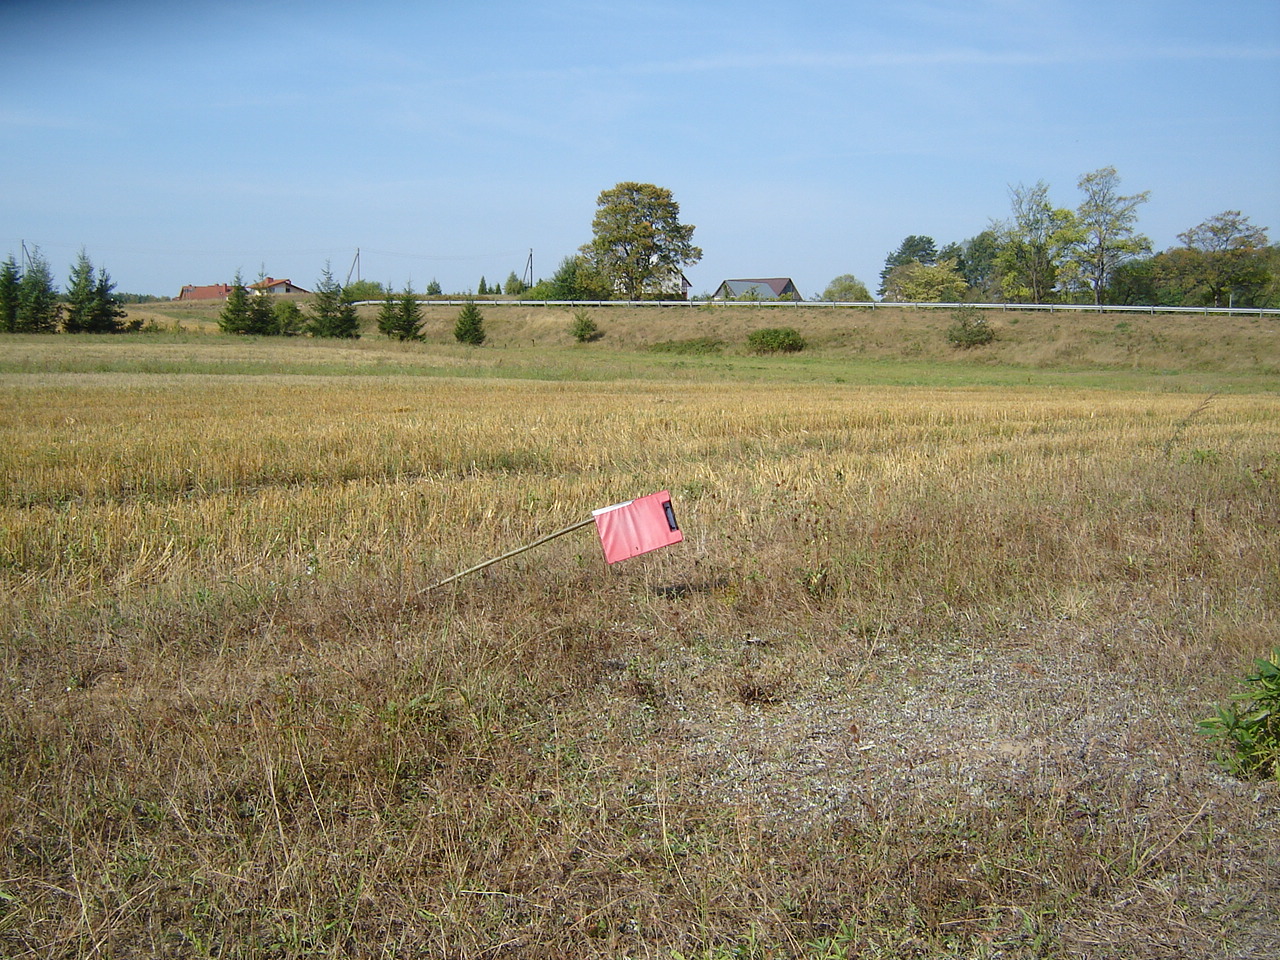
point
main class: Grassland
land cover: Grassland without tree/shrub cover
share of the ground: > 75 %
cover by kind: herbaceous plants 100 %
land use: Agriculture (excluding fallow land and kitchen gardens)
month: August
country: LT
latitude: 54.6147
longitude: 24.9001
